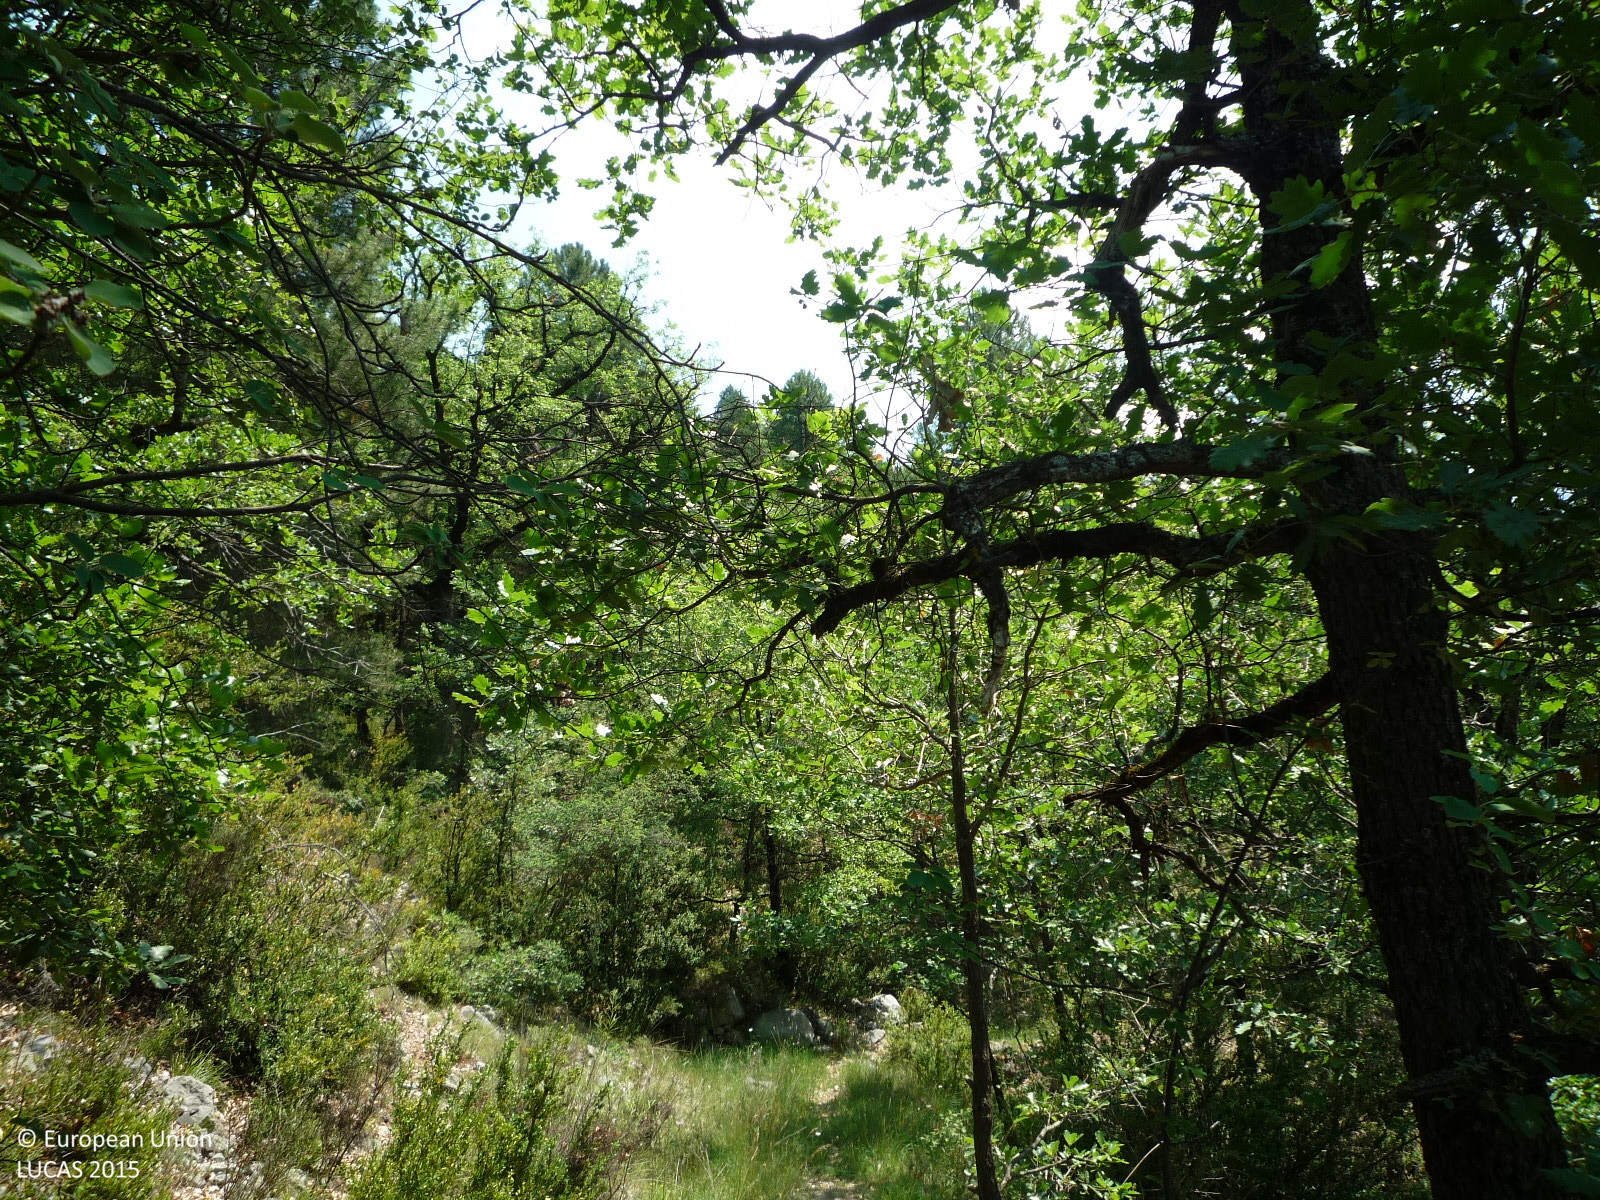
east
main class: Woodland
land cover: Broadleaved woodland
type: acidophilous oak and oak-birch forest
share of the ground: > 75 %
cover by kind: broadleaved forest trees 60 %, shrubs 20 %, herbaceous plants 10 %, lichens and mosses 10 %
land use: Semi-natural and natural areas not in use
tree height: > 5 m
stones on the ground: > 50 %
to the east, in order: Broadleaved woodland; Shrubland with sparse tree cover; Tracks; Shrubland with sparse tree cover; Tracks; Pine dominated mixed woodland; Shrubland with sparse tree cover; Broadleaved woodland; Rivers and streams; Broadleaved woodland
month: June
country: ES
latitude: 42.3229
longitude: 1.6016
